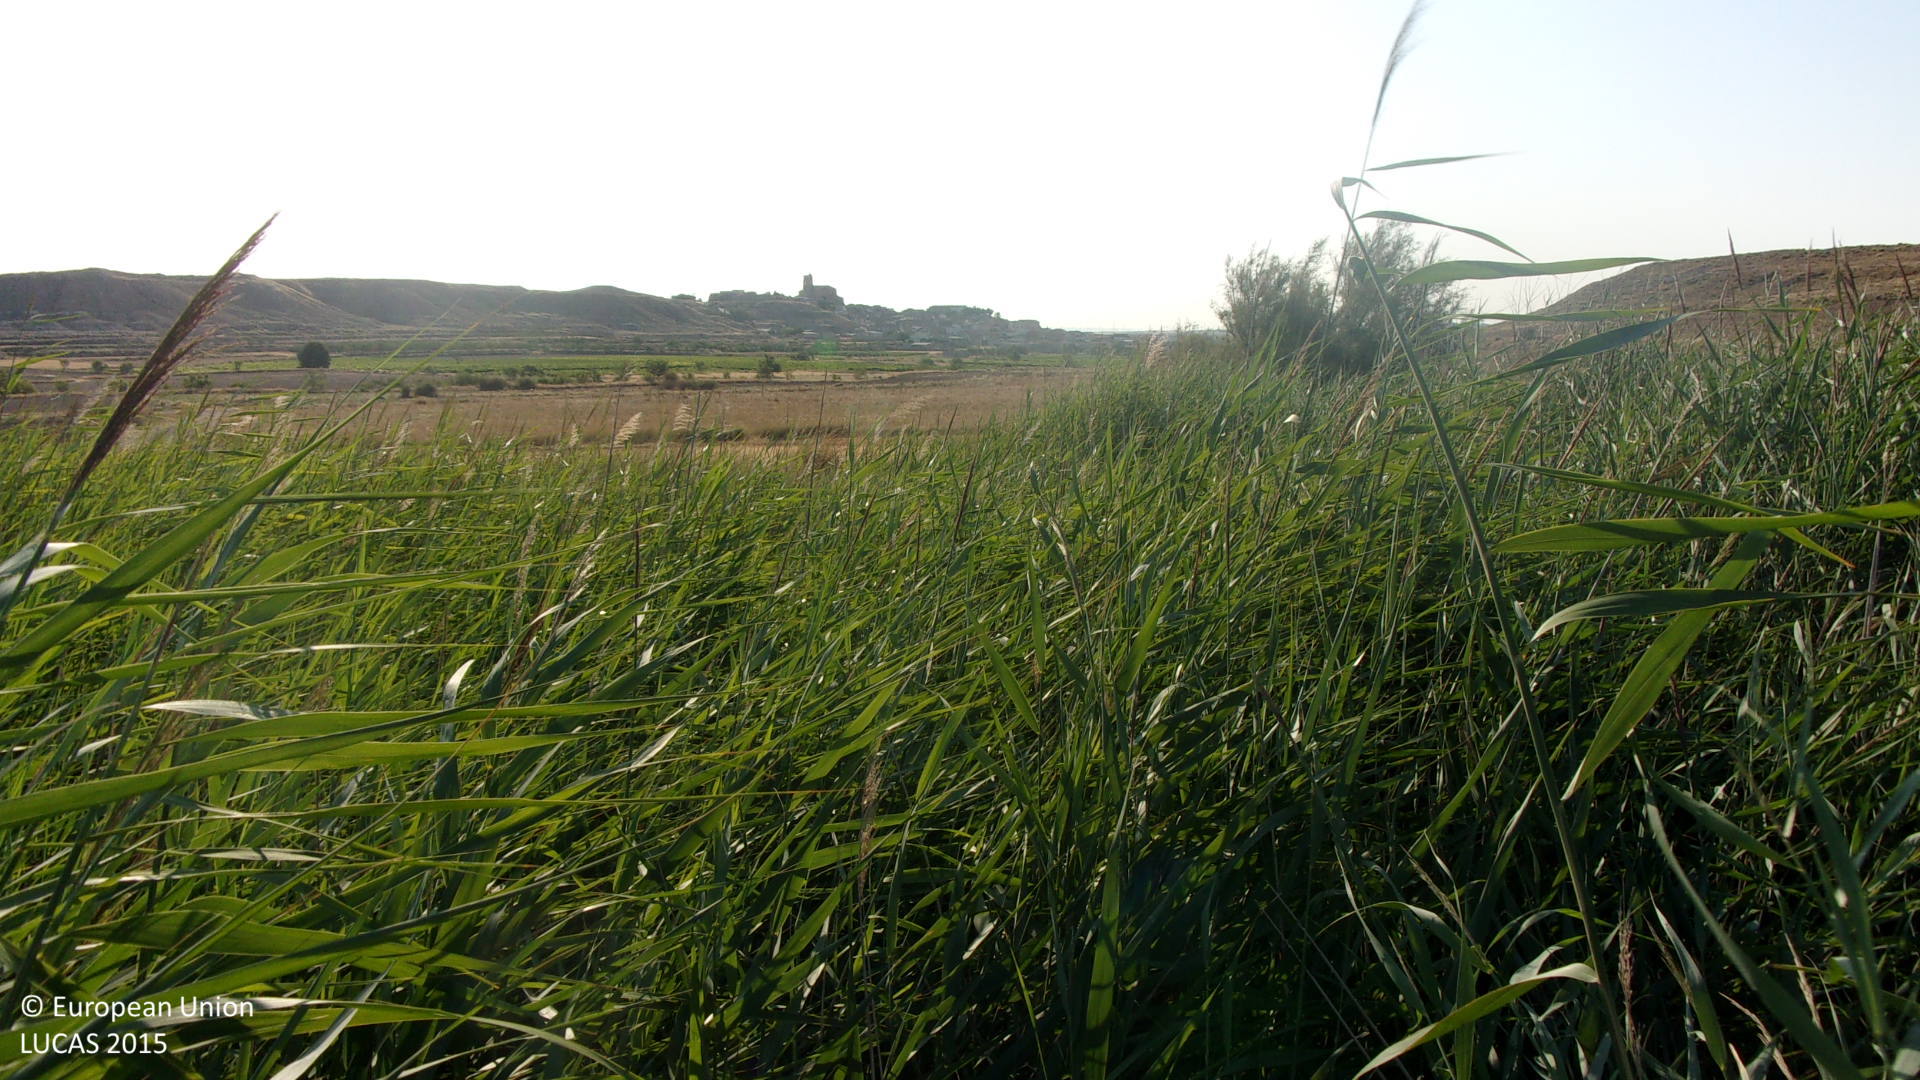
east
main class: Shrubland
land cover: Shrubland without tree cover
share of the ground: > 75 %
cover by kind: shrubs 100 %
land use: Semi-natural and natural areas not in use
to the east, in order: Shrubland without tree cover; Barley; Spontaneously vegetated surfaces; Grass margins; Tracks; Grass margins; Spontaneously vegetated surfaces; Shruby margins; Spontaneously vegetated surfaces; Grass margins; Spontaneously vegetated surfaces
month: July
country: ES
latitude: 41.8350
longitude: -1.4802
